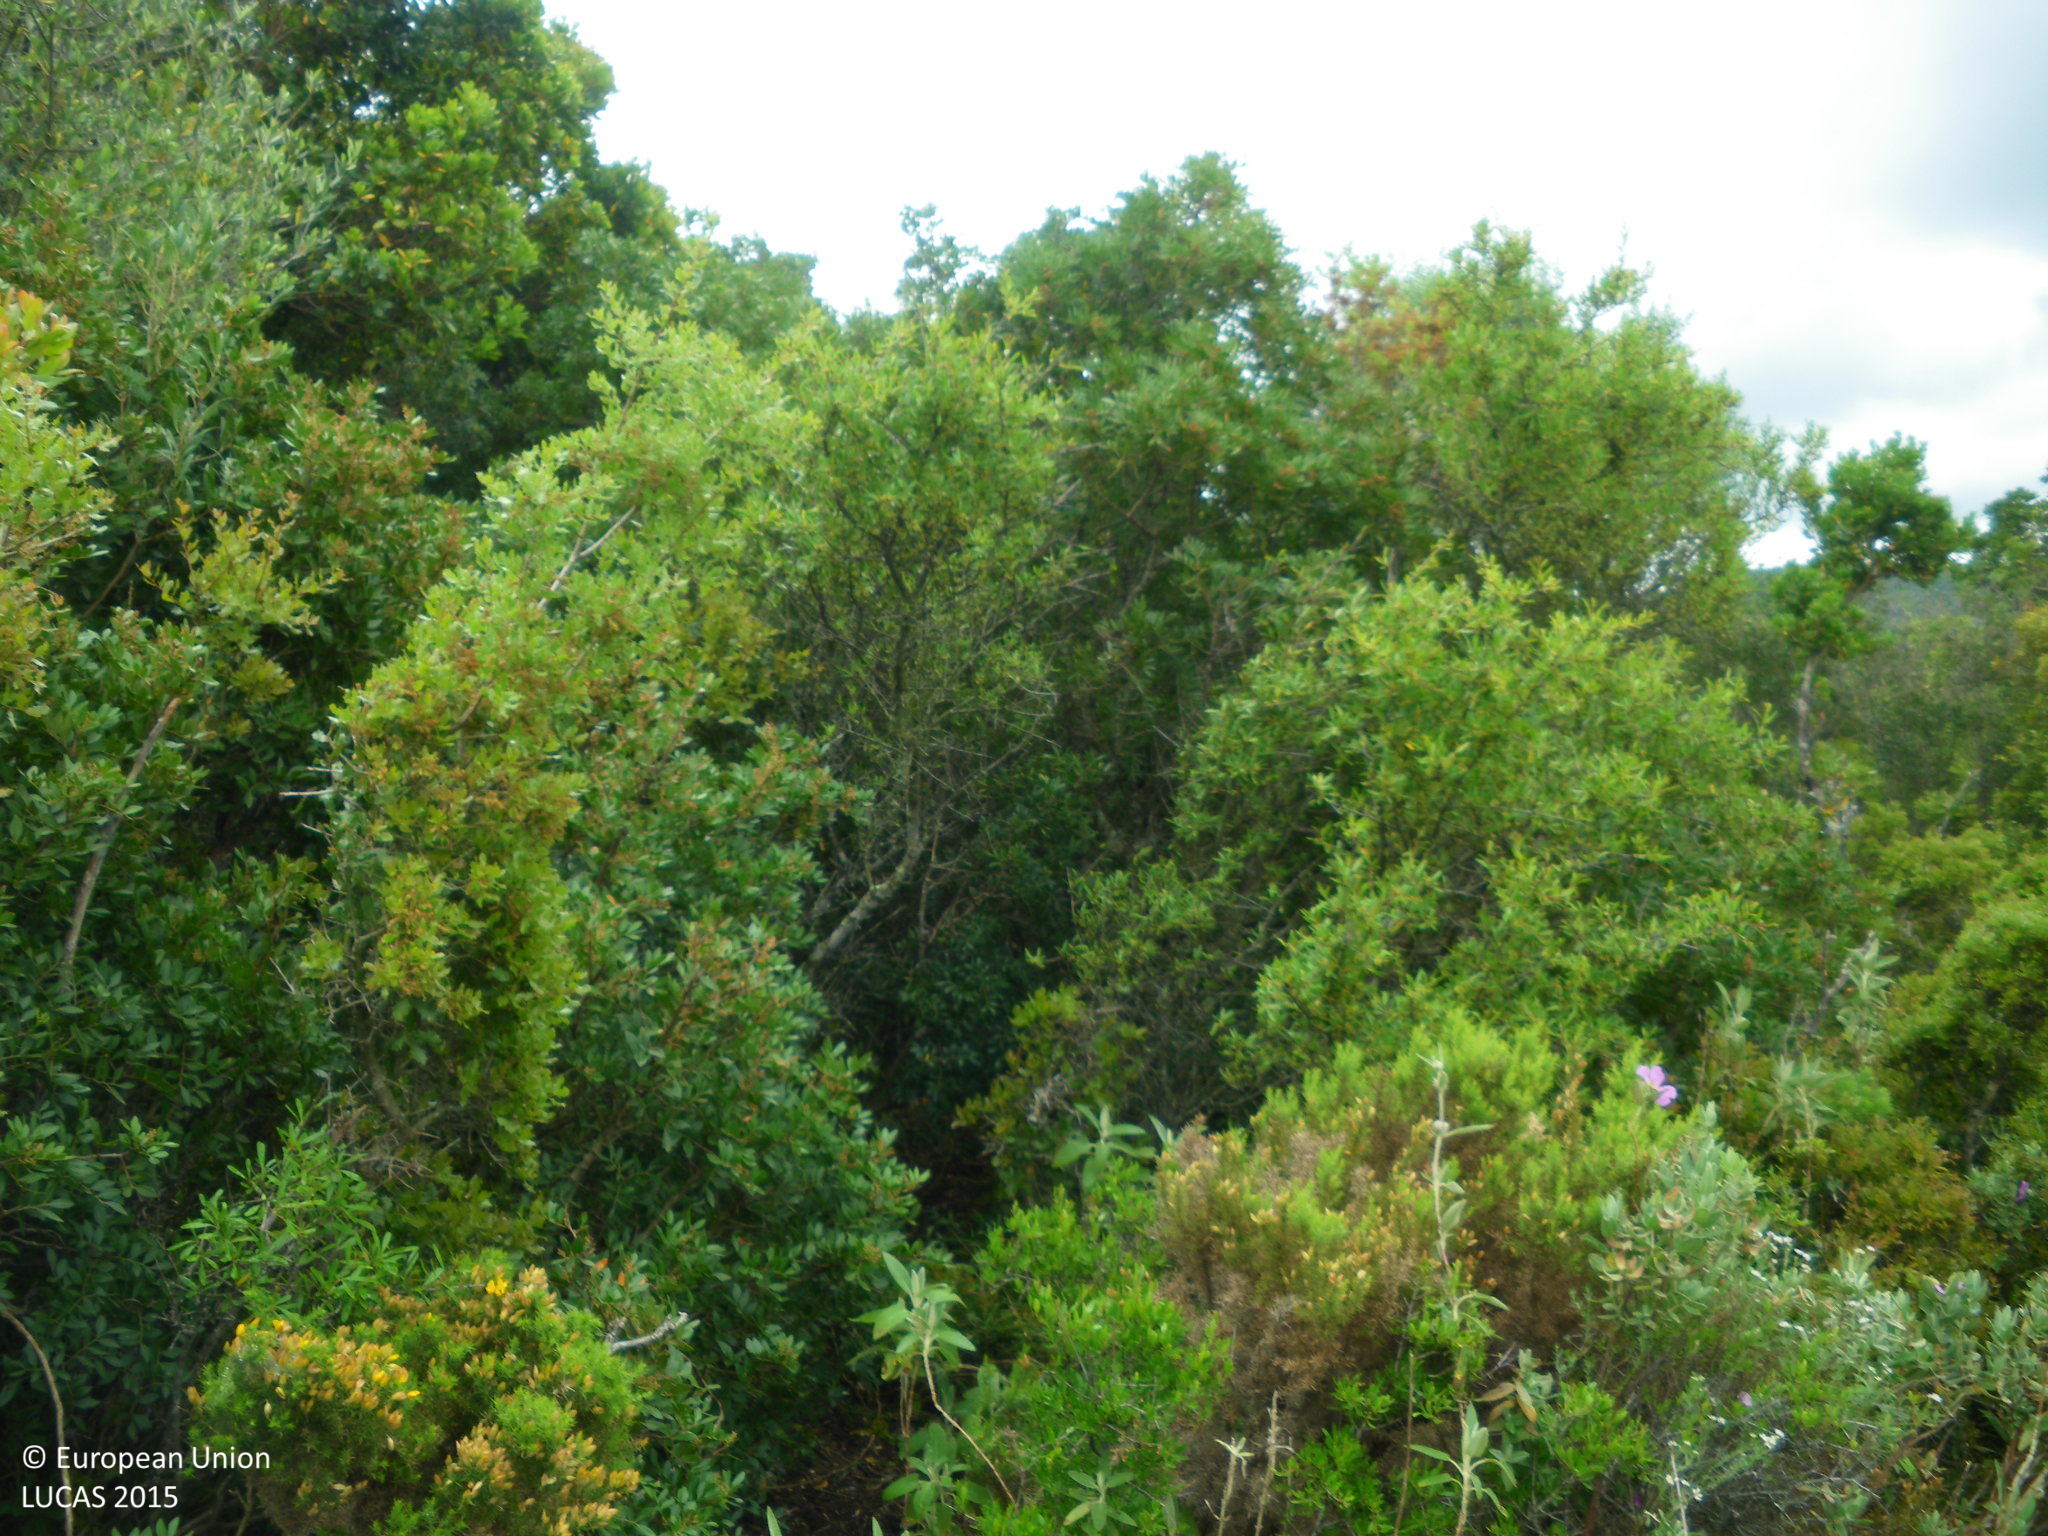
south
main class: Shrubland
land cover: Shrubland with sparse tree cover
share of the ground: > 75 %
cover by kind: shrubs 75 %, herbaceous plants 15 %, broadleaved forest trees 5 %, unconsolidated bare surface 5 %
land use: Agriculture (excluding fallow land and kitchen gardens)
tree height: < 5 m
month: April
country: ES
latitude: 36.5811
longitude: -5.7059
